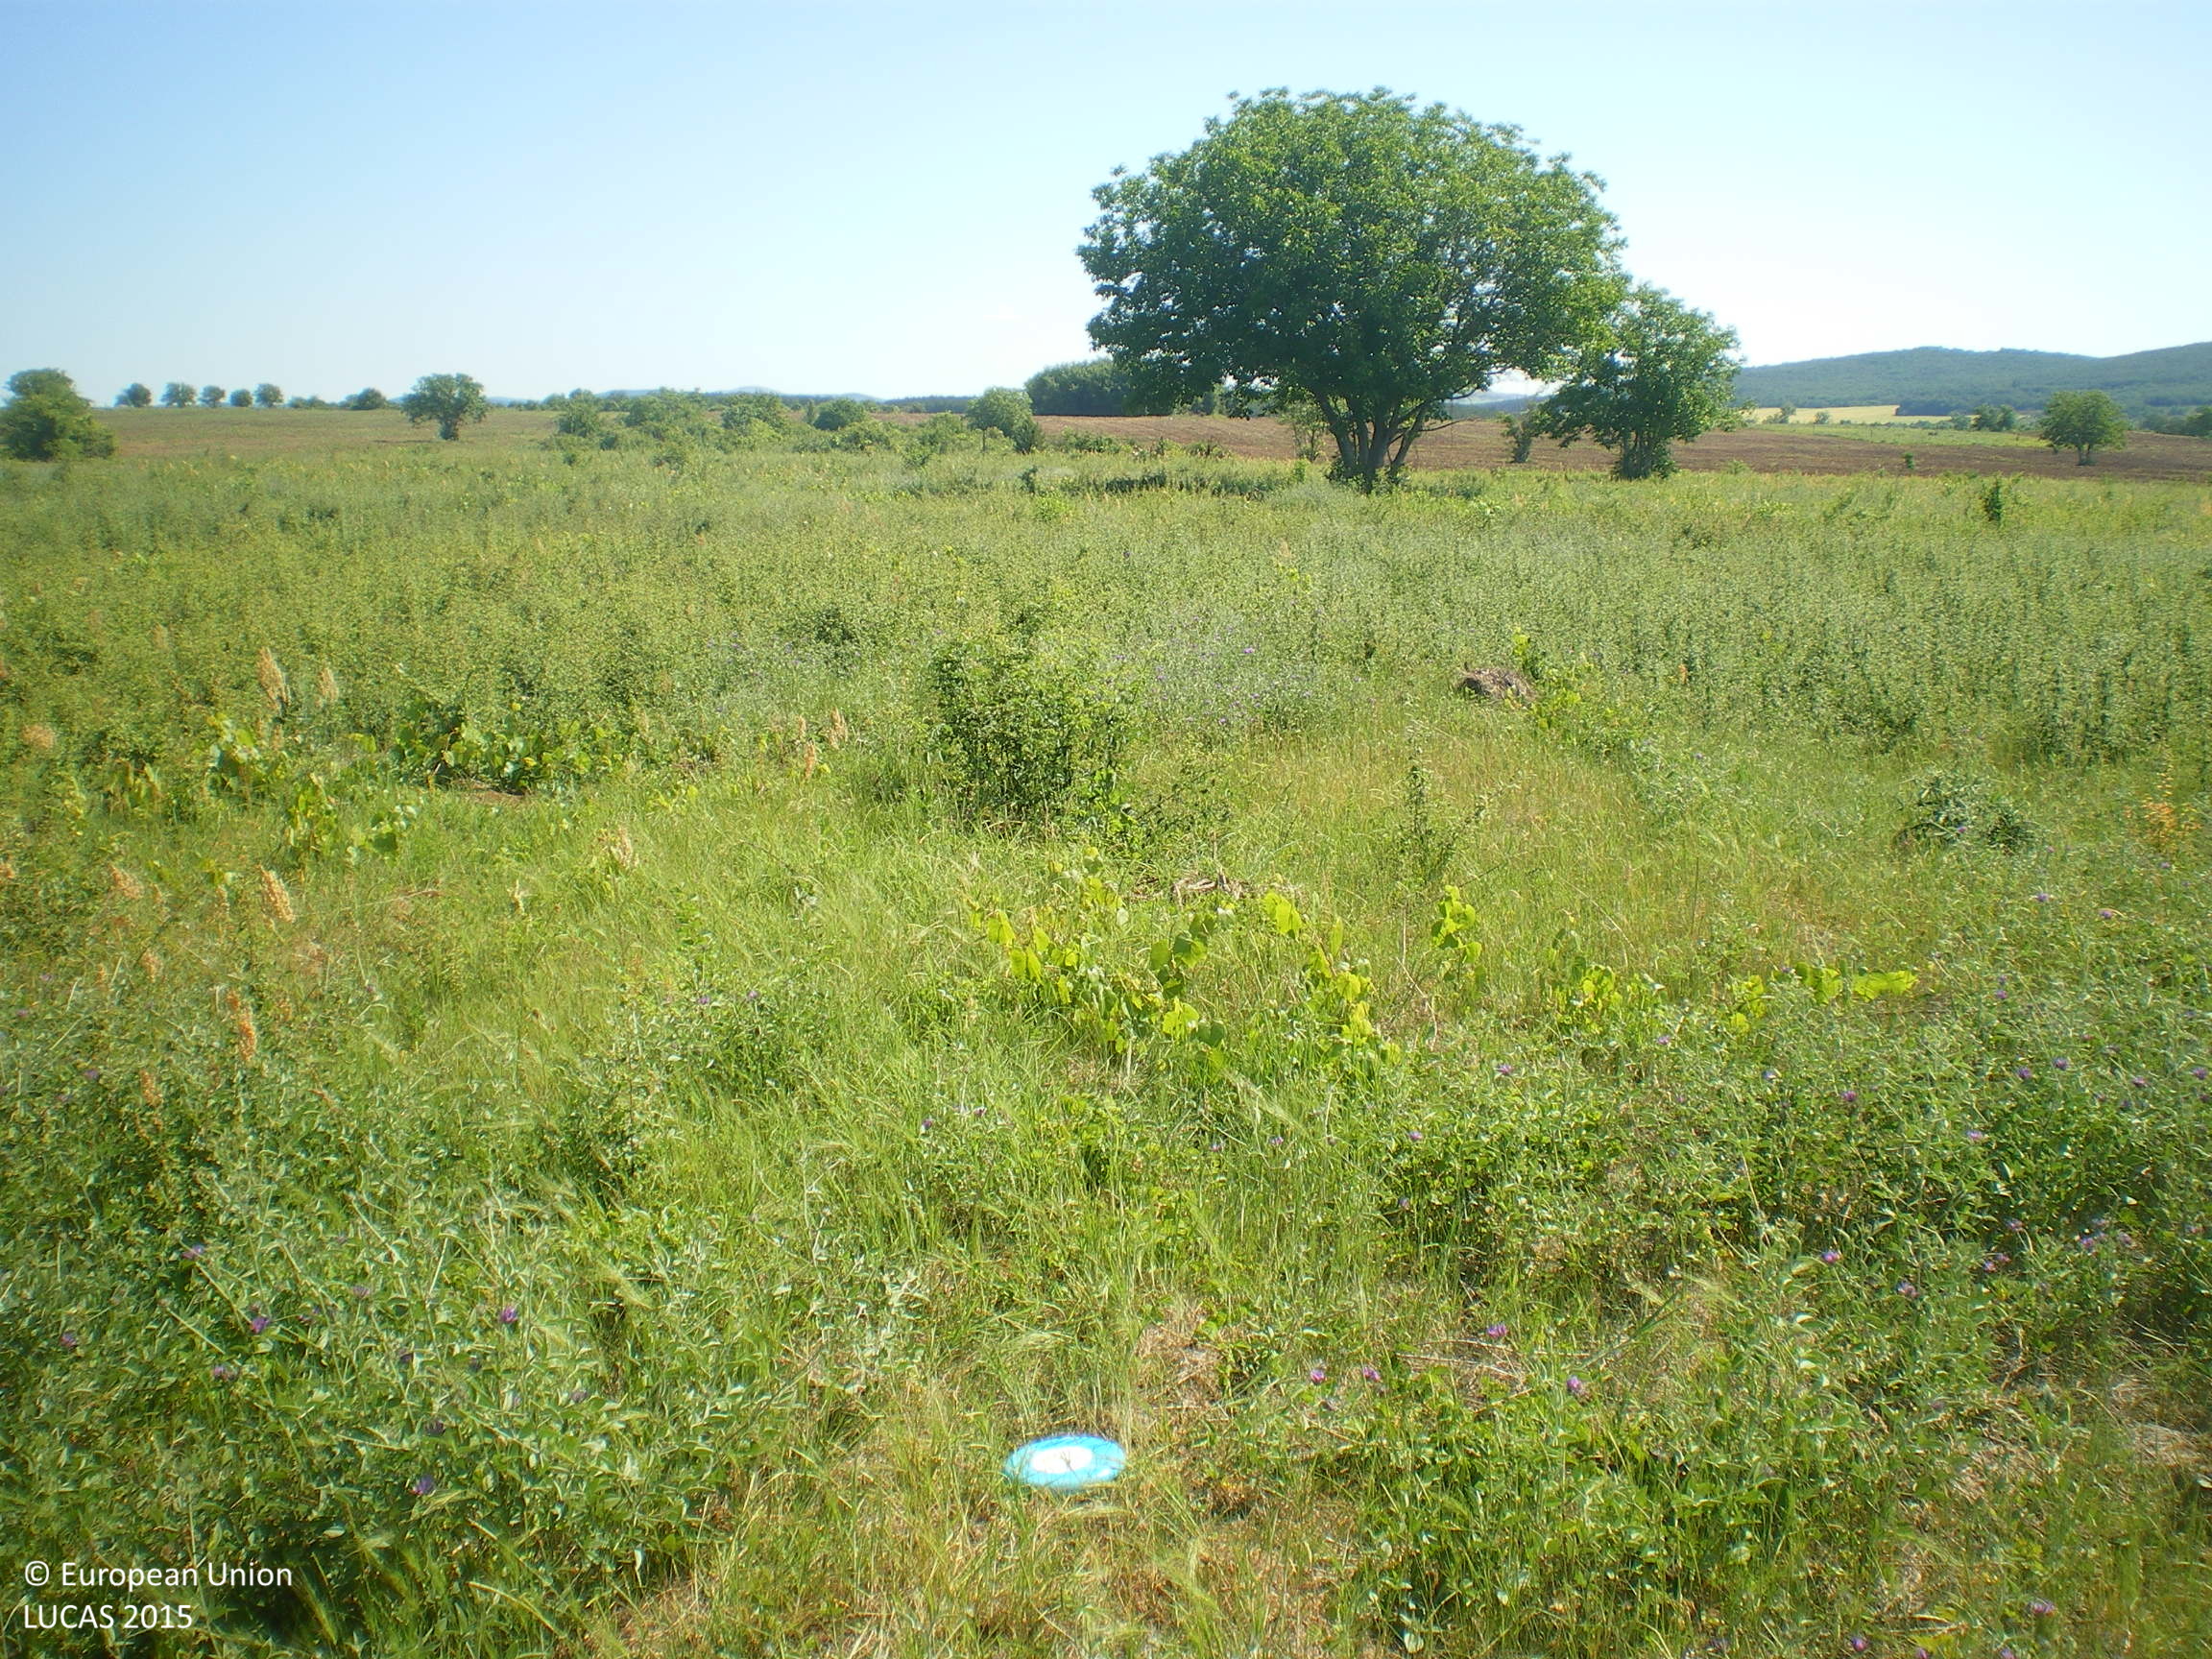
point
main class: Cropland
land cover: Vineyards
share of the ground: 10 - 25 %
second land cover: Shrubland without tree cover
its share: 50 - 75 %
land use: Abandoned areas
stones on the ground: < 10 %
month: June
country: BG
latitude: 42.3029
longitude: 25.4605
